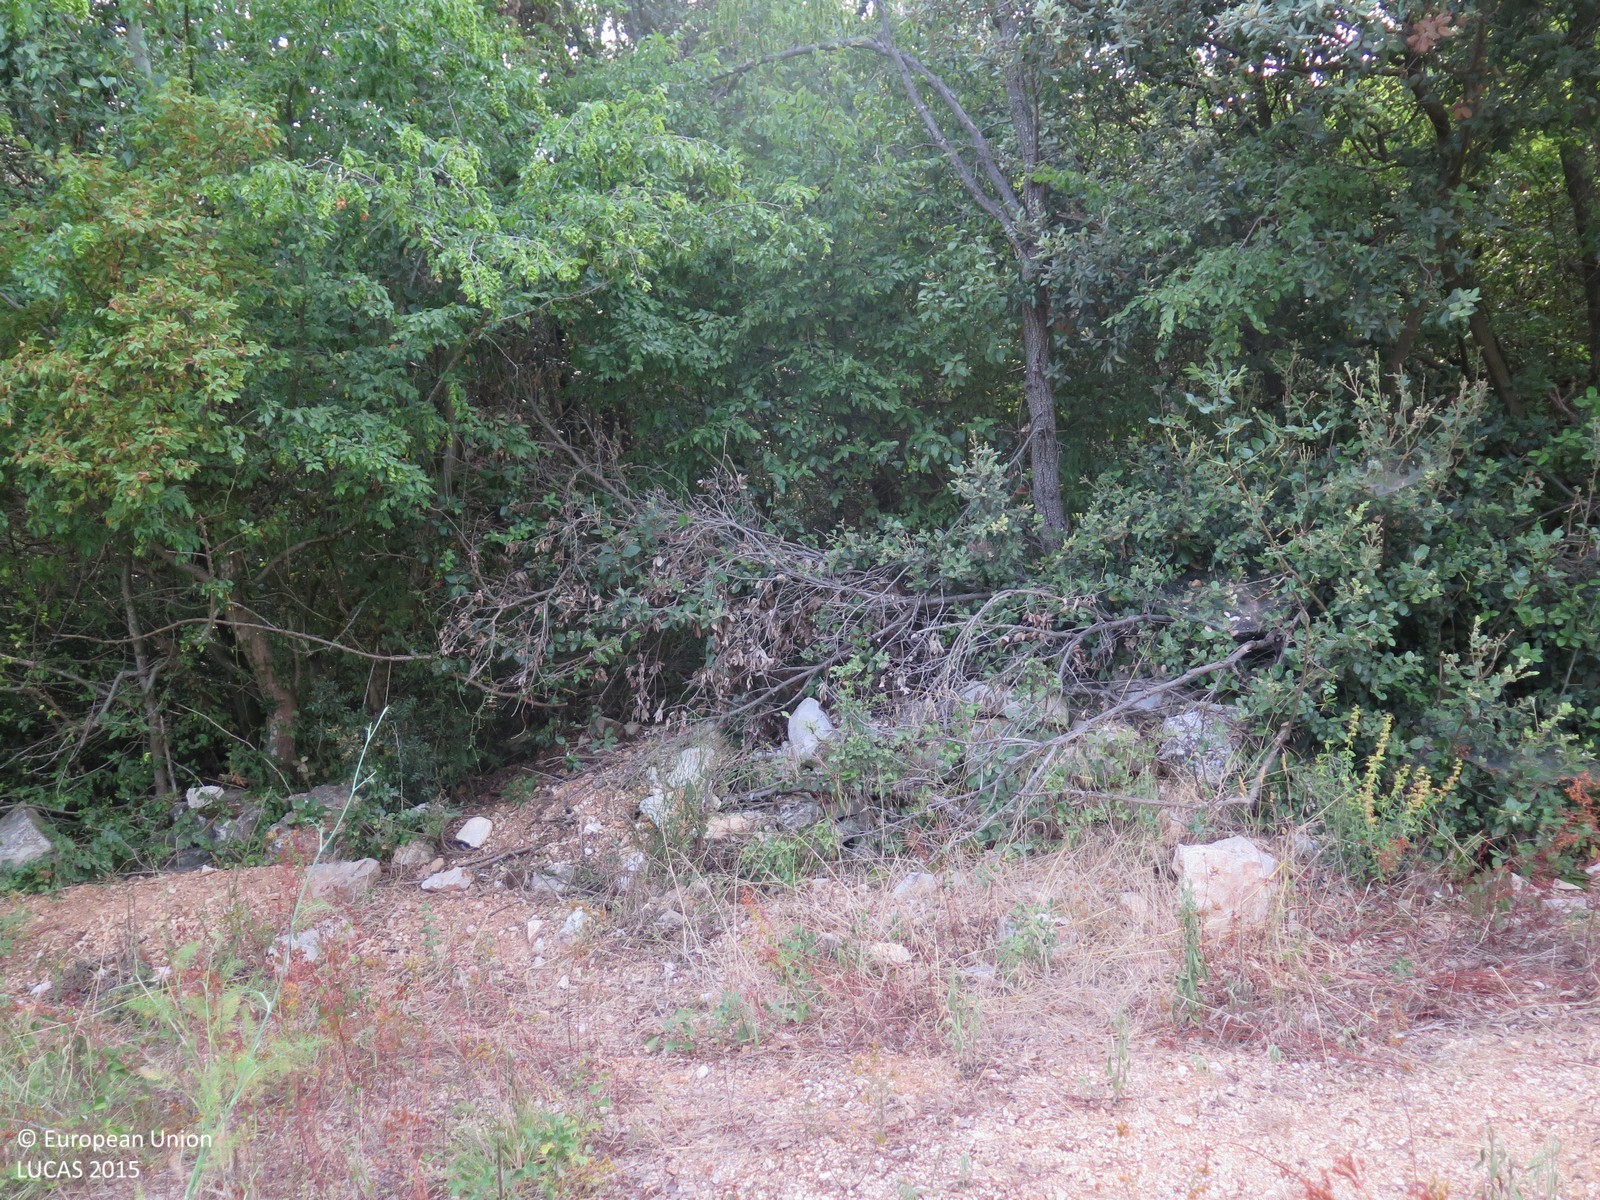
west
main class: Grassland
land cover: Grassland with sparse tree/shrub cover
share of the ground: 50 - 75 %
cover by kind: herbaceous plants 90 %, broadleaved forest trees 5 %, shrubs 5 %
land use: Agriculture (excluding fallow land and kitchen gardens)
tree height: > 5 m
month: July
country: HR
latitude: 45.0431
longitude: 13.6889
